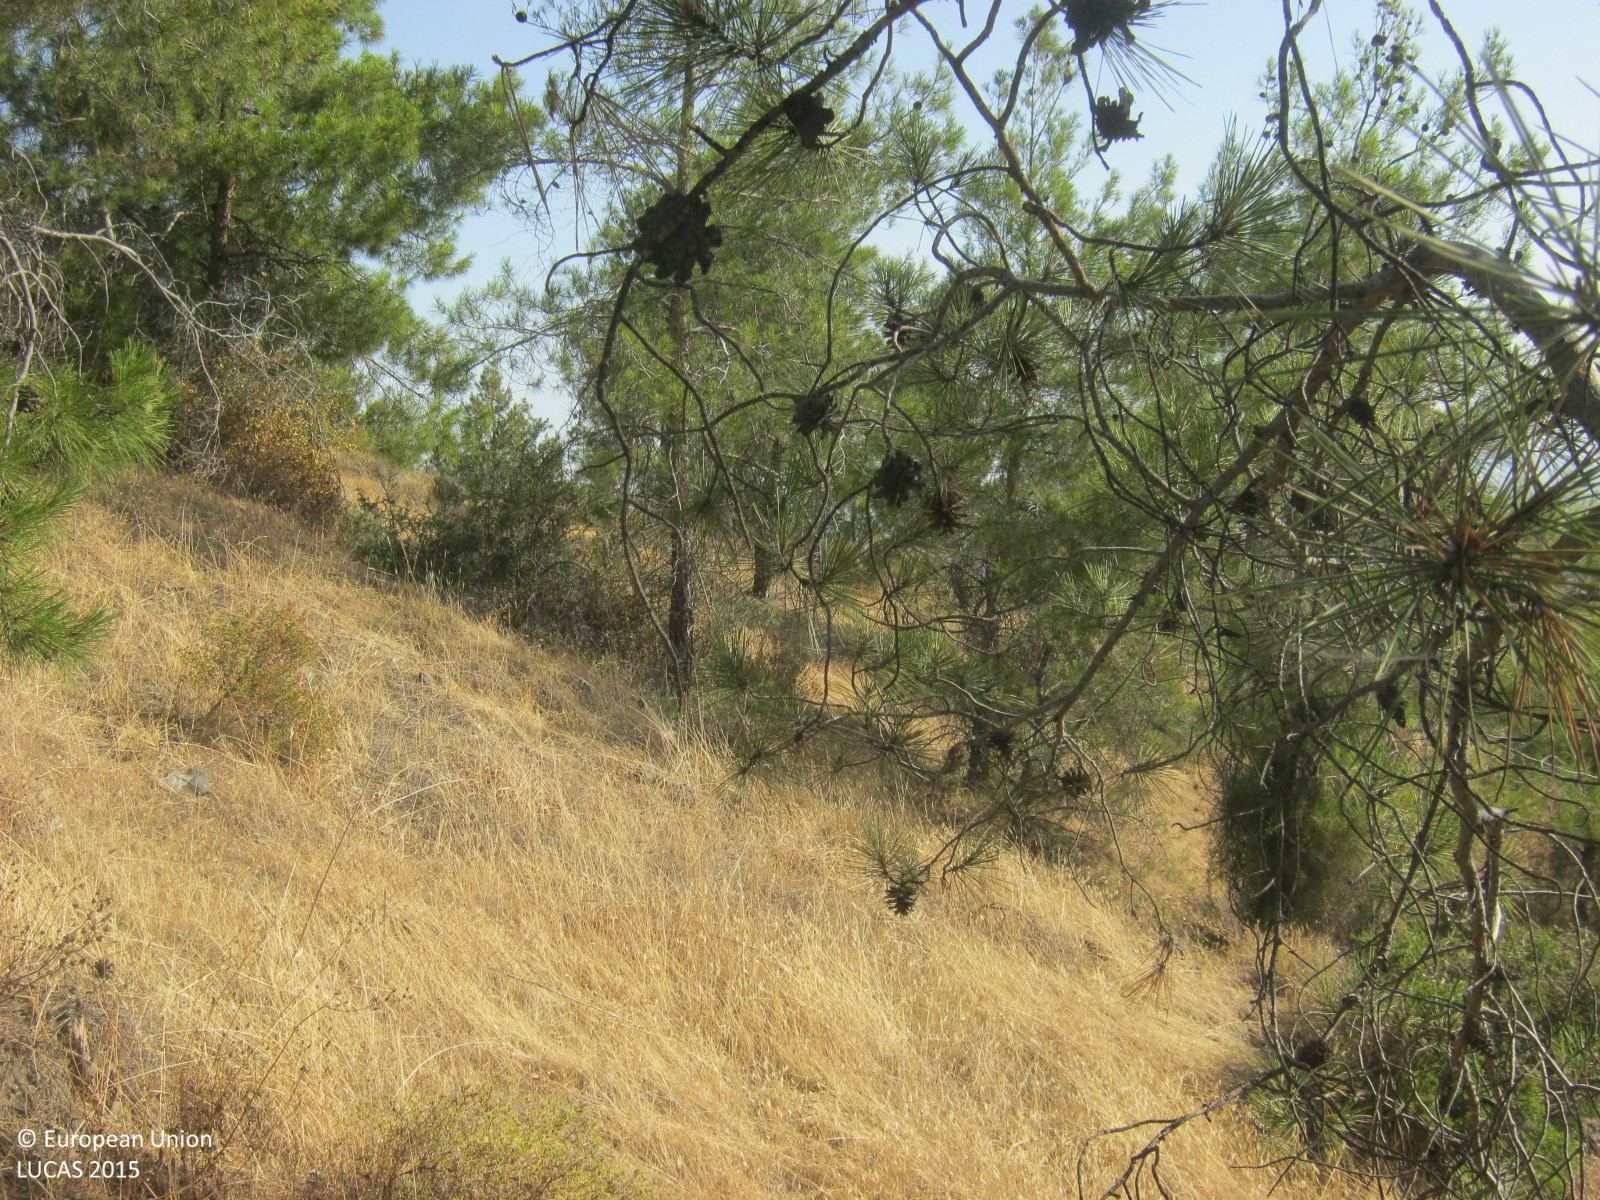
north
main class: Woodland
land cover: Pine dominated coniferous woodland
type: coniferous forest of the mediterranean region
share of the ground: > 75 %
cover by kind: coniferous forest trees 75 %, herbaceous plants 15 %, shrubs 10 %
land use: Forestry
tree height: > 5 m
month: June
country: CY
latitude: 35.0583
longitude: 32.9928
